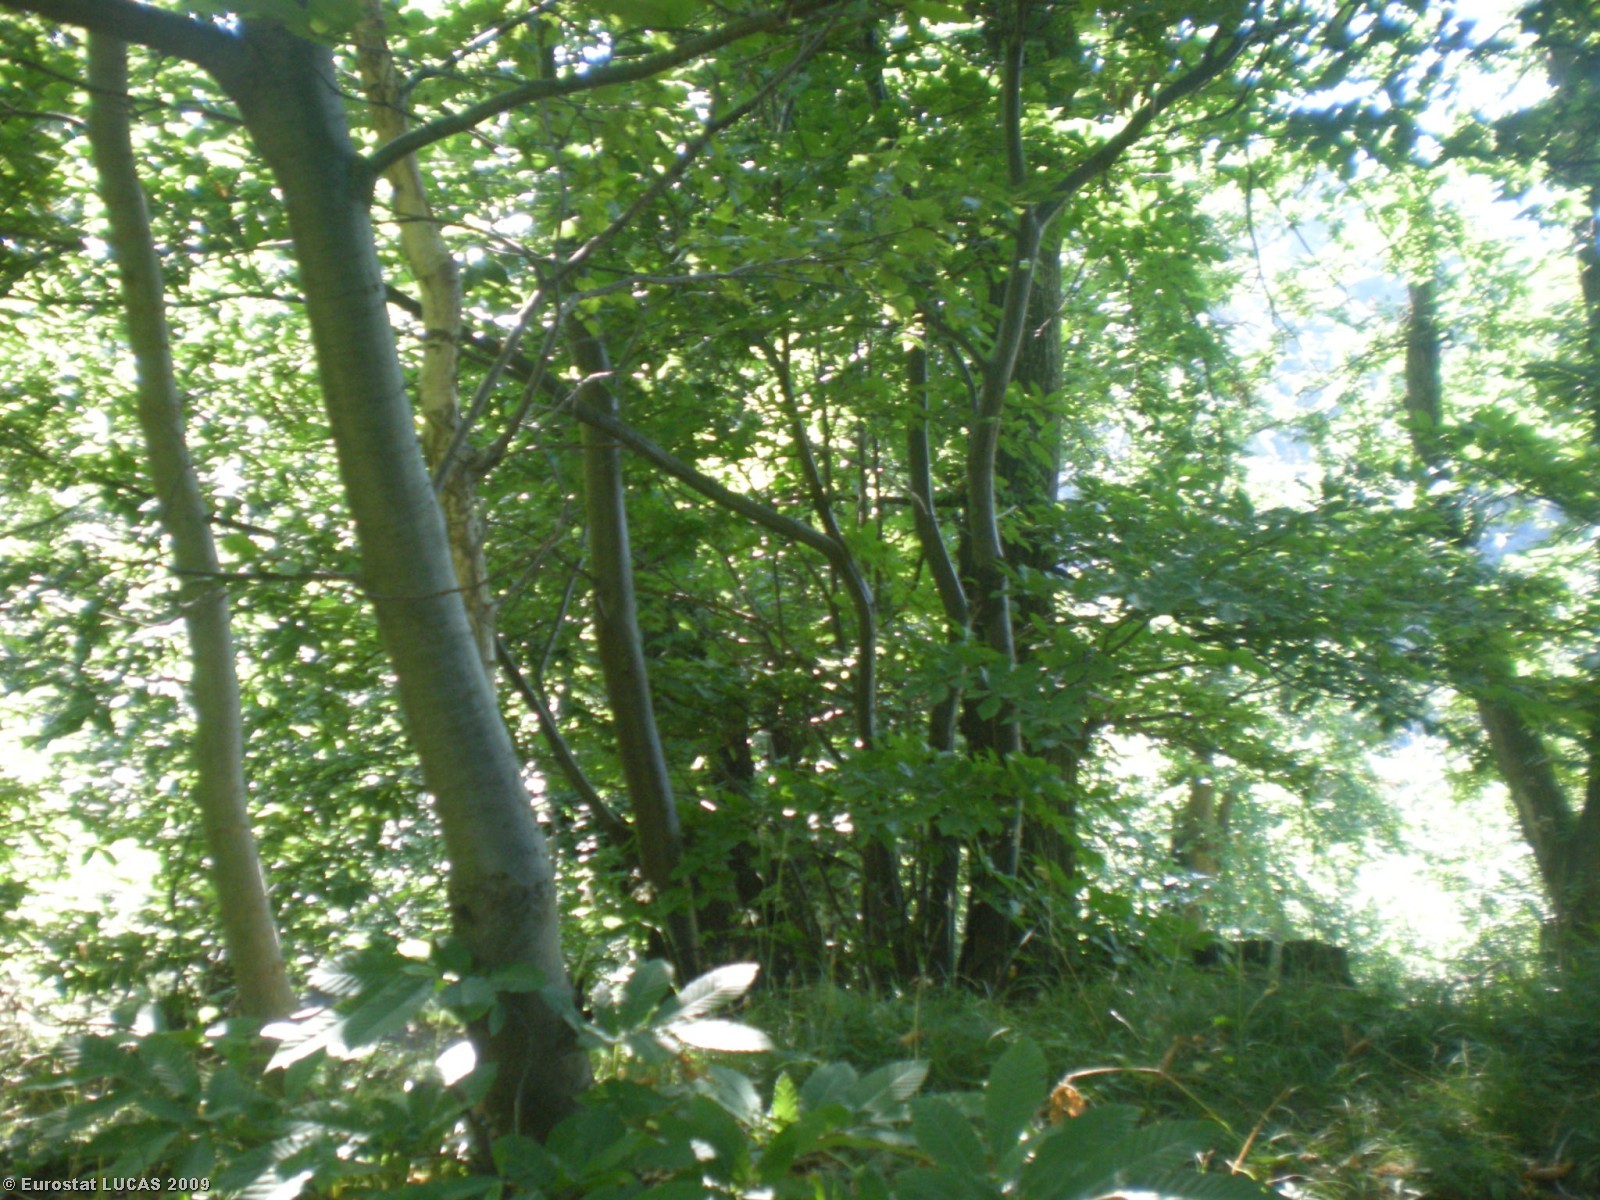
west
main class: Woodland
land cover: Broadleaved woodland
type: mesophytic deciduous forest
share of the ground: > 75 %
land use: Forestry
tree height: > 5 m
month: July
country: IT
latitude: 44.5519
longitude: 7.3743
